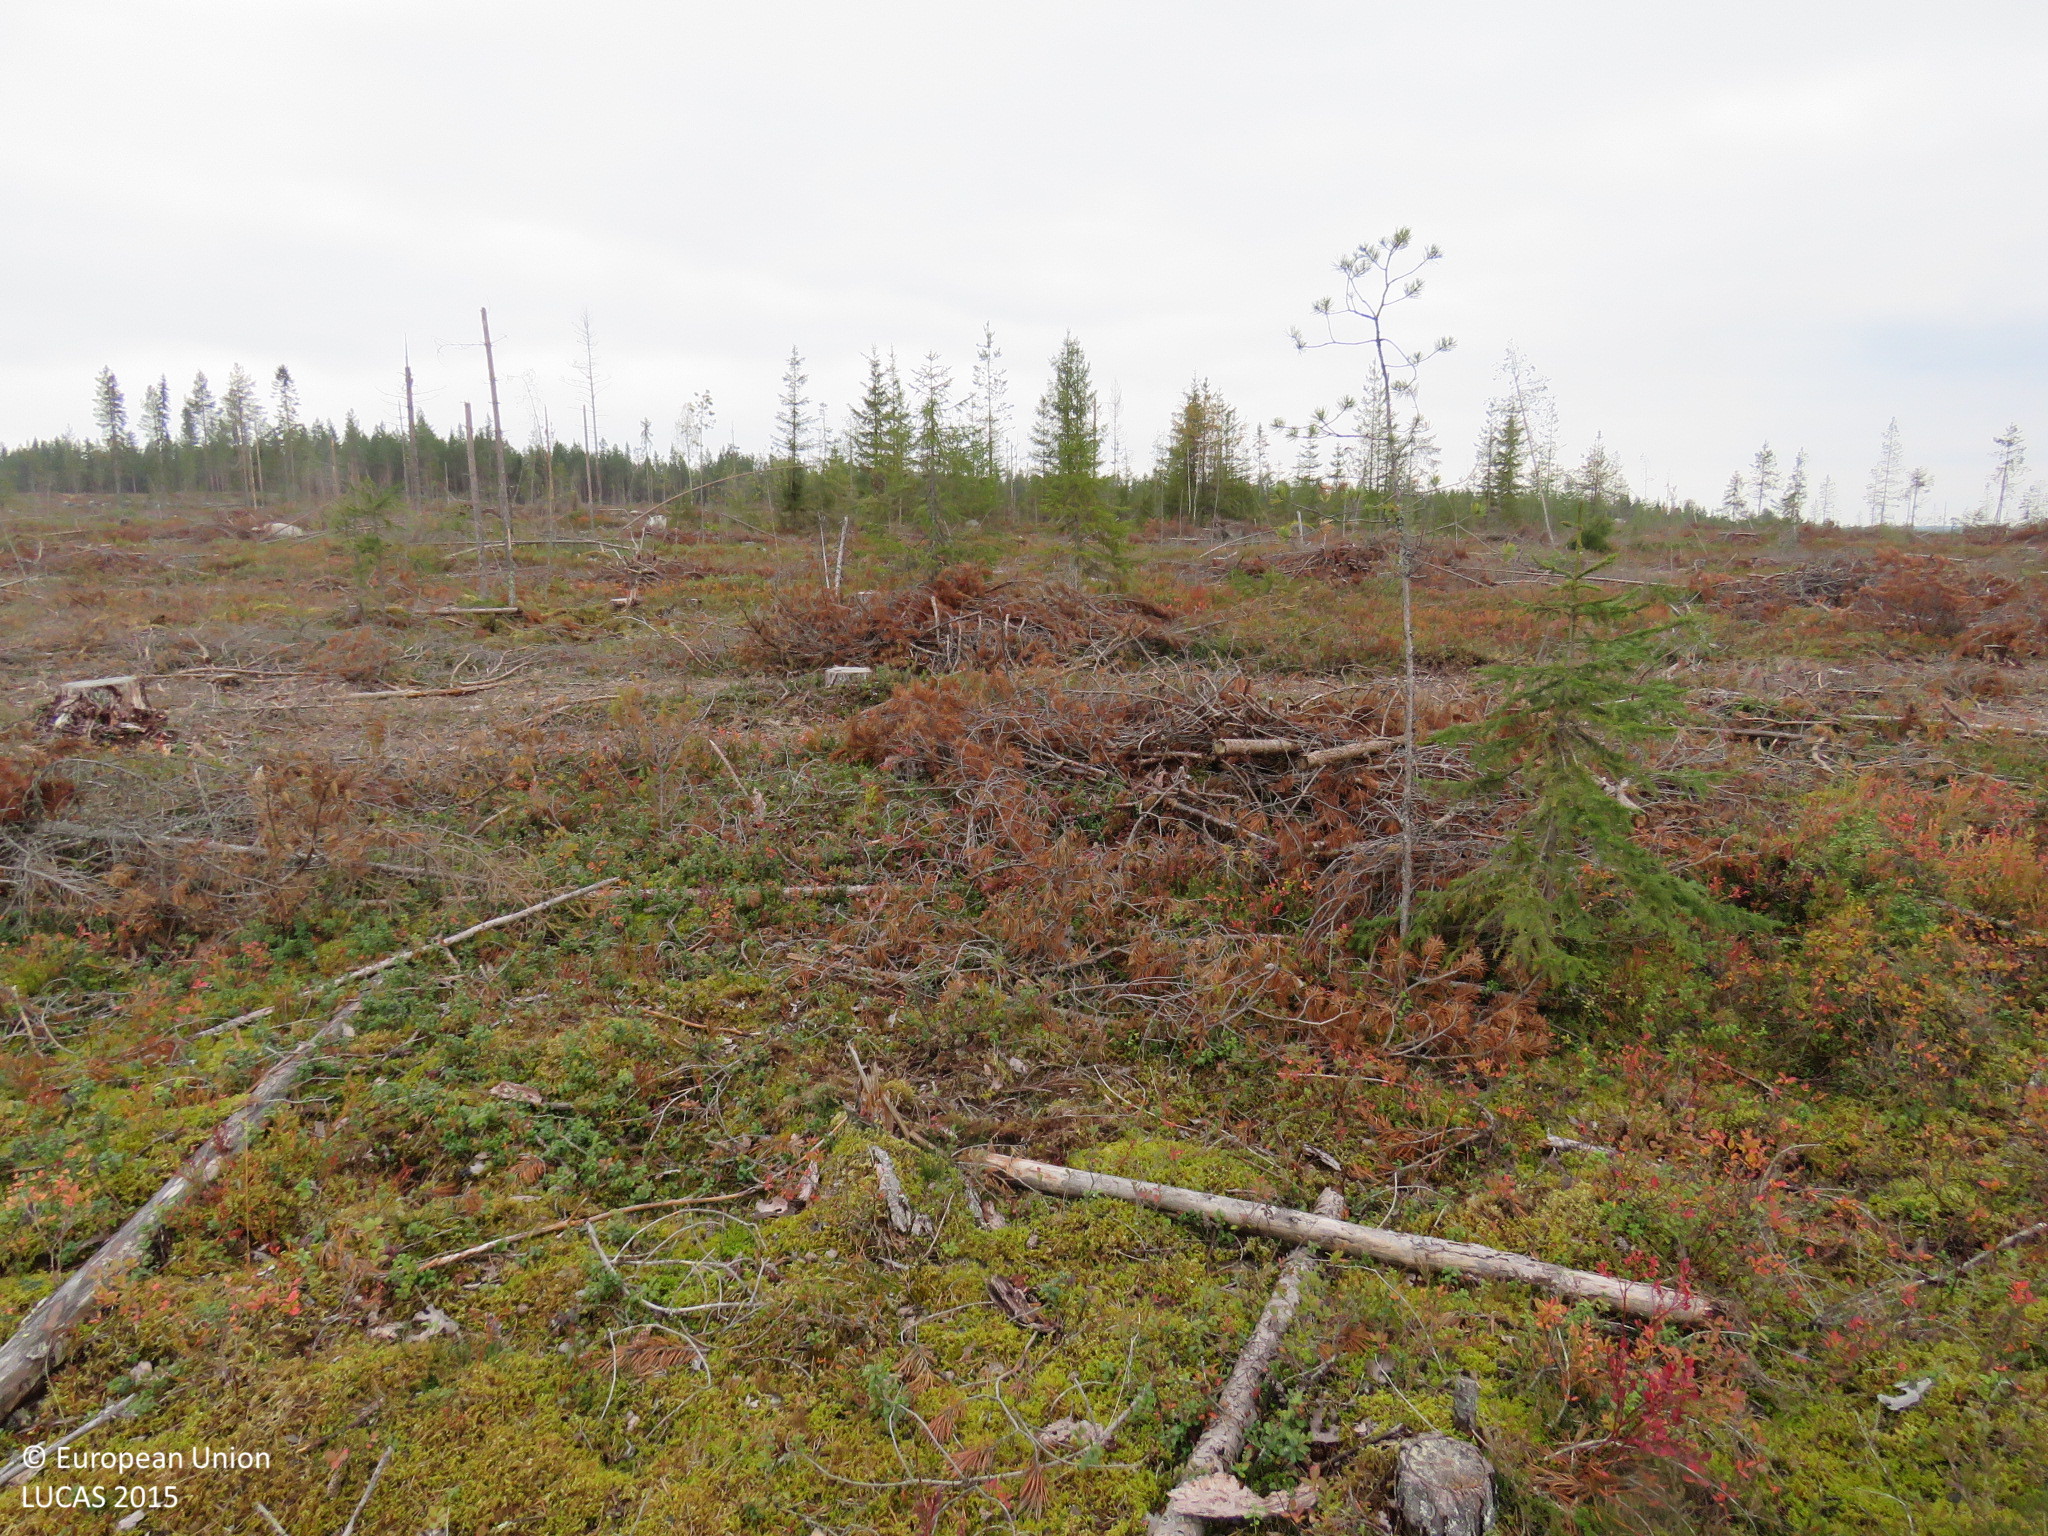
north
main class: Shrubland
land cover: Shrubland with sparse tree cover
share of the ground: 50 - 75 %
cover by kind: shrubs 55 %, lichens and mosses 30 %, coniferous forest trees 5 %, unconsolidated bare surface 5 %
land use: Forestry
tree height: < 5 m
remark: Clear cut
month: September
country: FI
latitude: 65.2923
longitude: 26.6389
